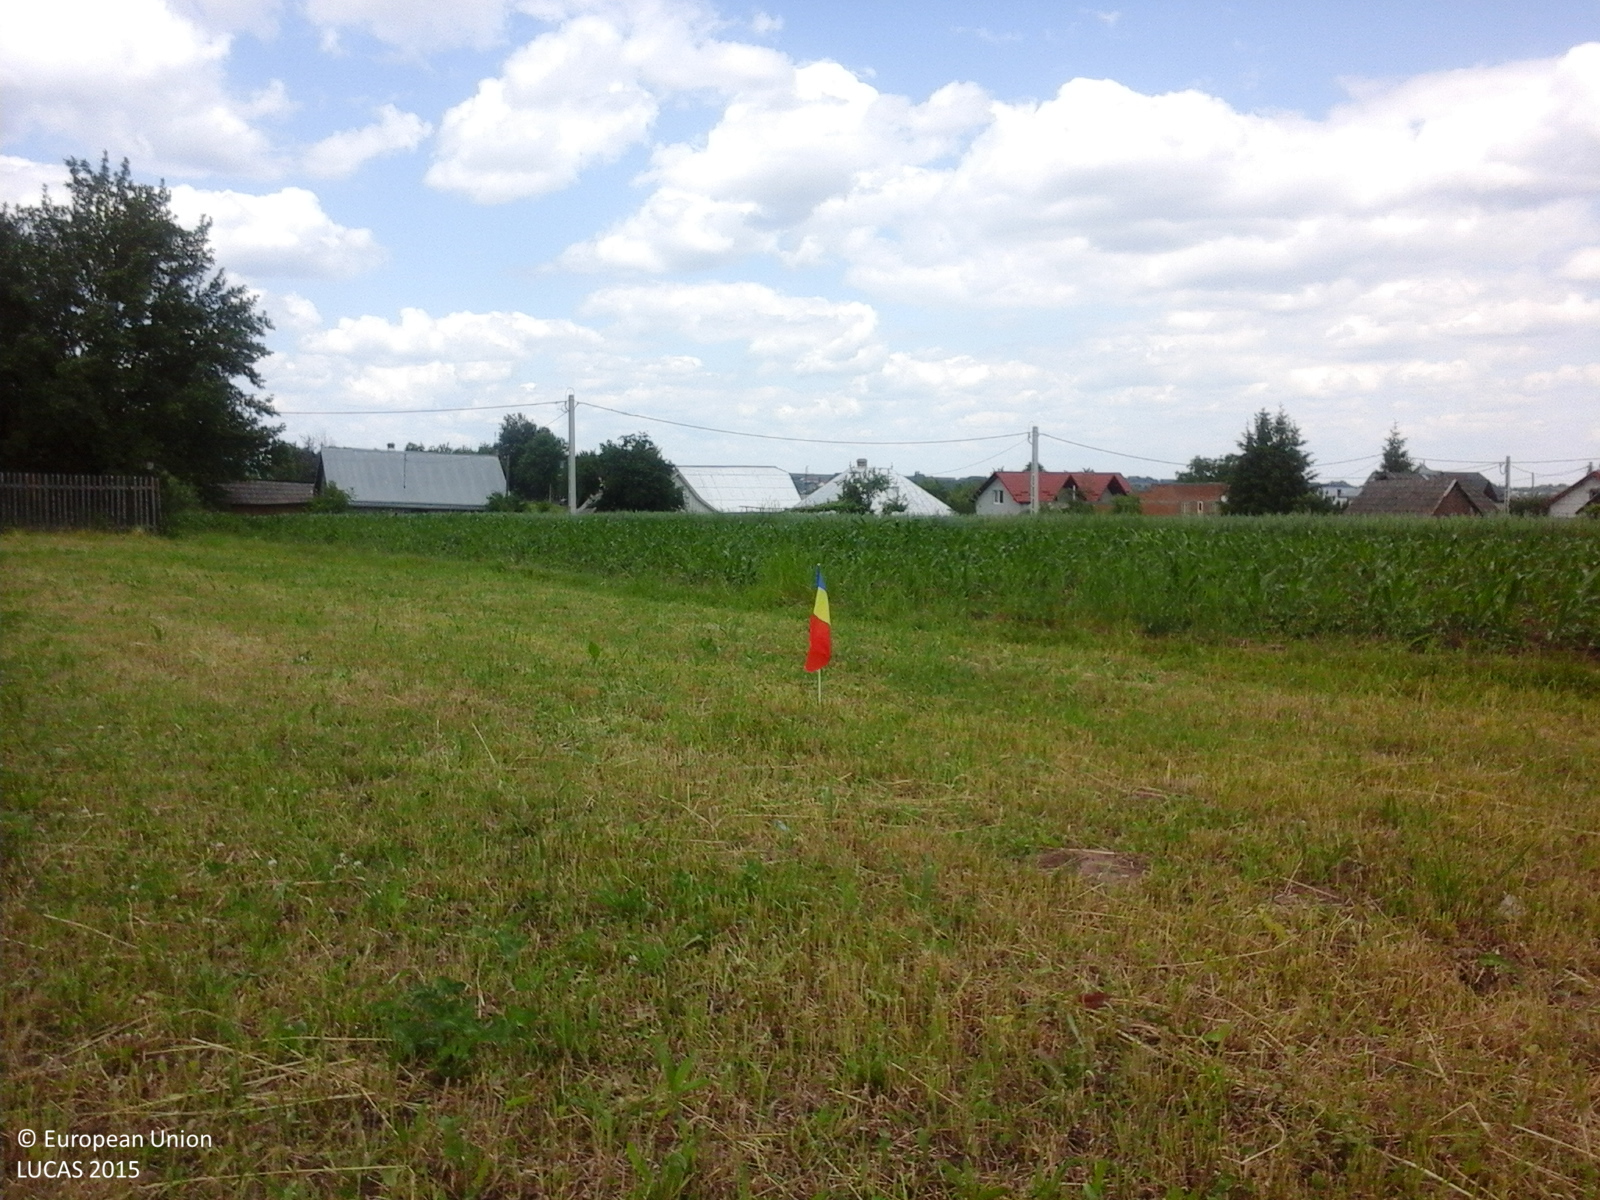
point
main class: Grassland
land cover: Grassland without tree/shrub cover
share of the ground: > 75 %
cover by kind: herbaceous plants 100 %
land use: Agriculture (excluding fallow land and kitchen gardens)
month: June
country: RO
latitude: 47.8408
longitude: 25.8265
